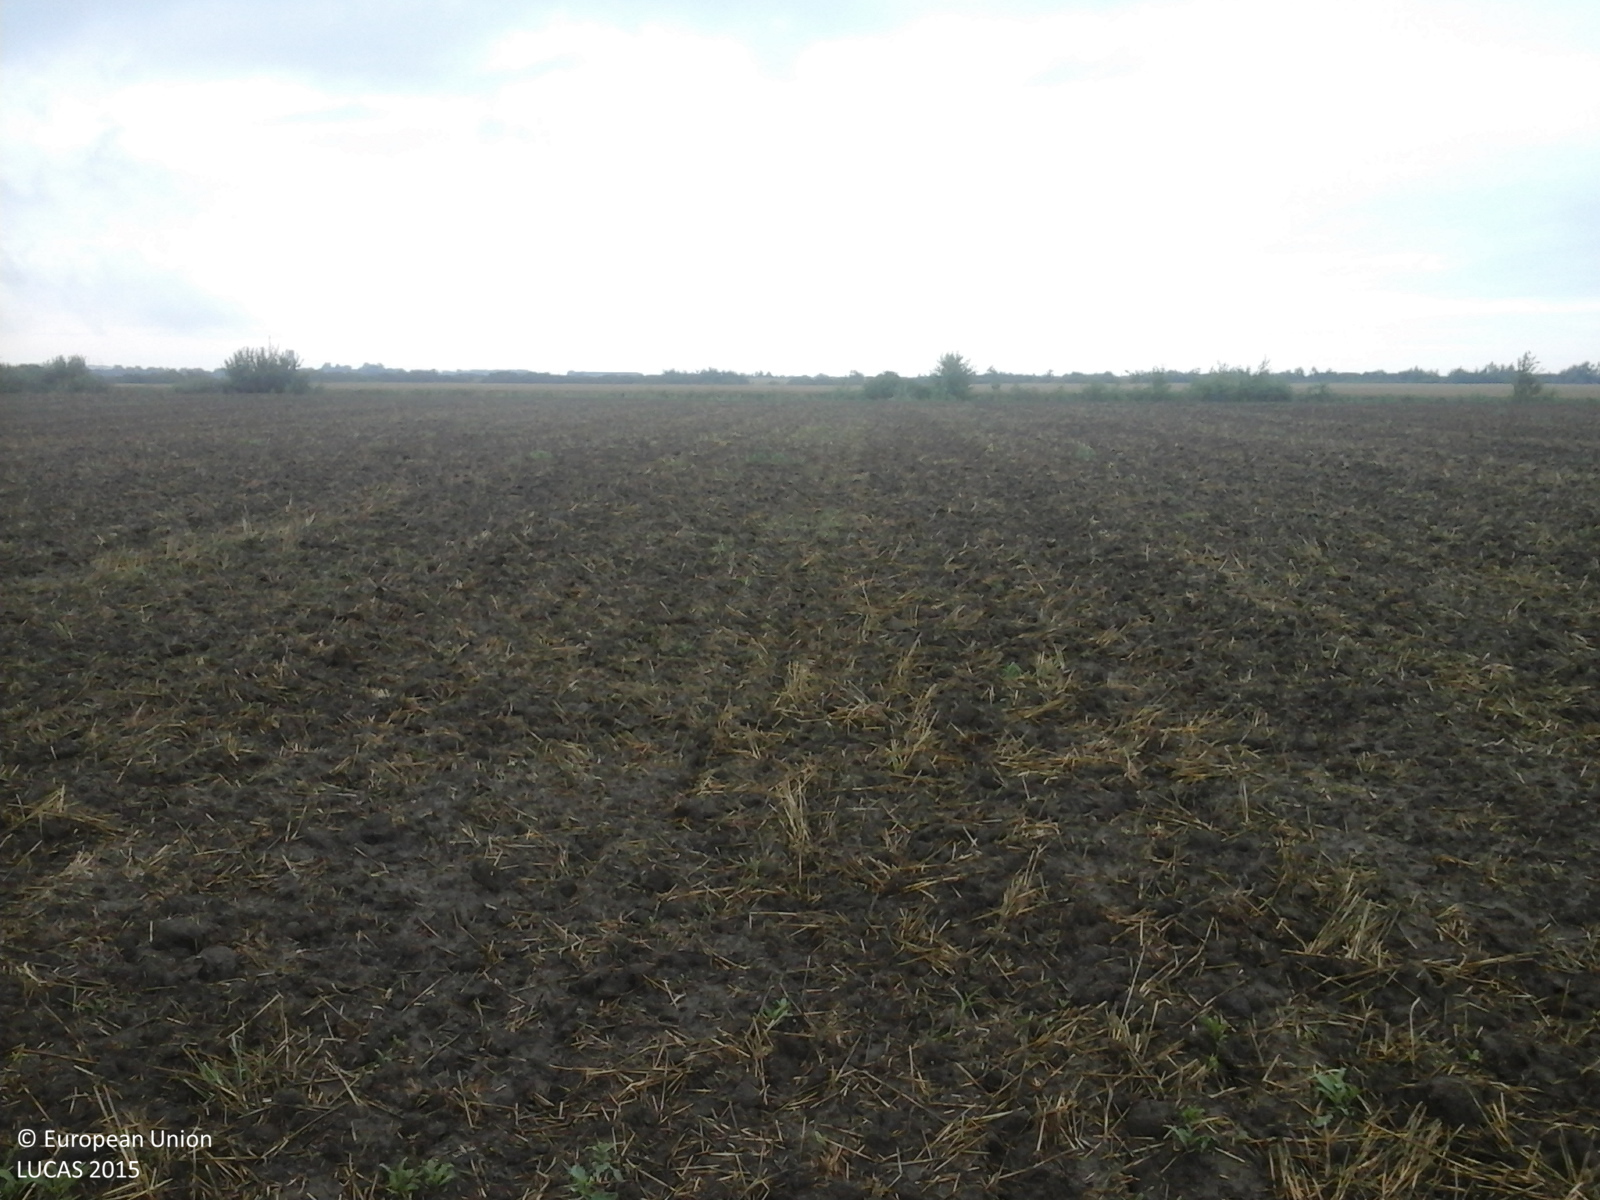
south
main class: Cropland
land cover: Common wheat
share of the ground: < 10 %
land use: Agriculture (excluding fallow land and kitchen gardens)
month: August
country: RO
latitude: 45.6006
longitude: 21.1701
